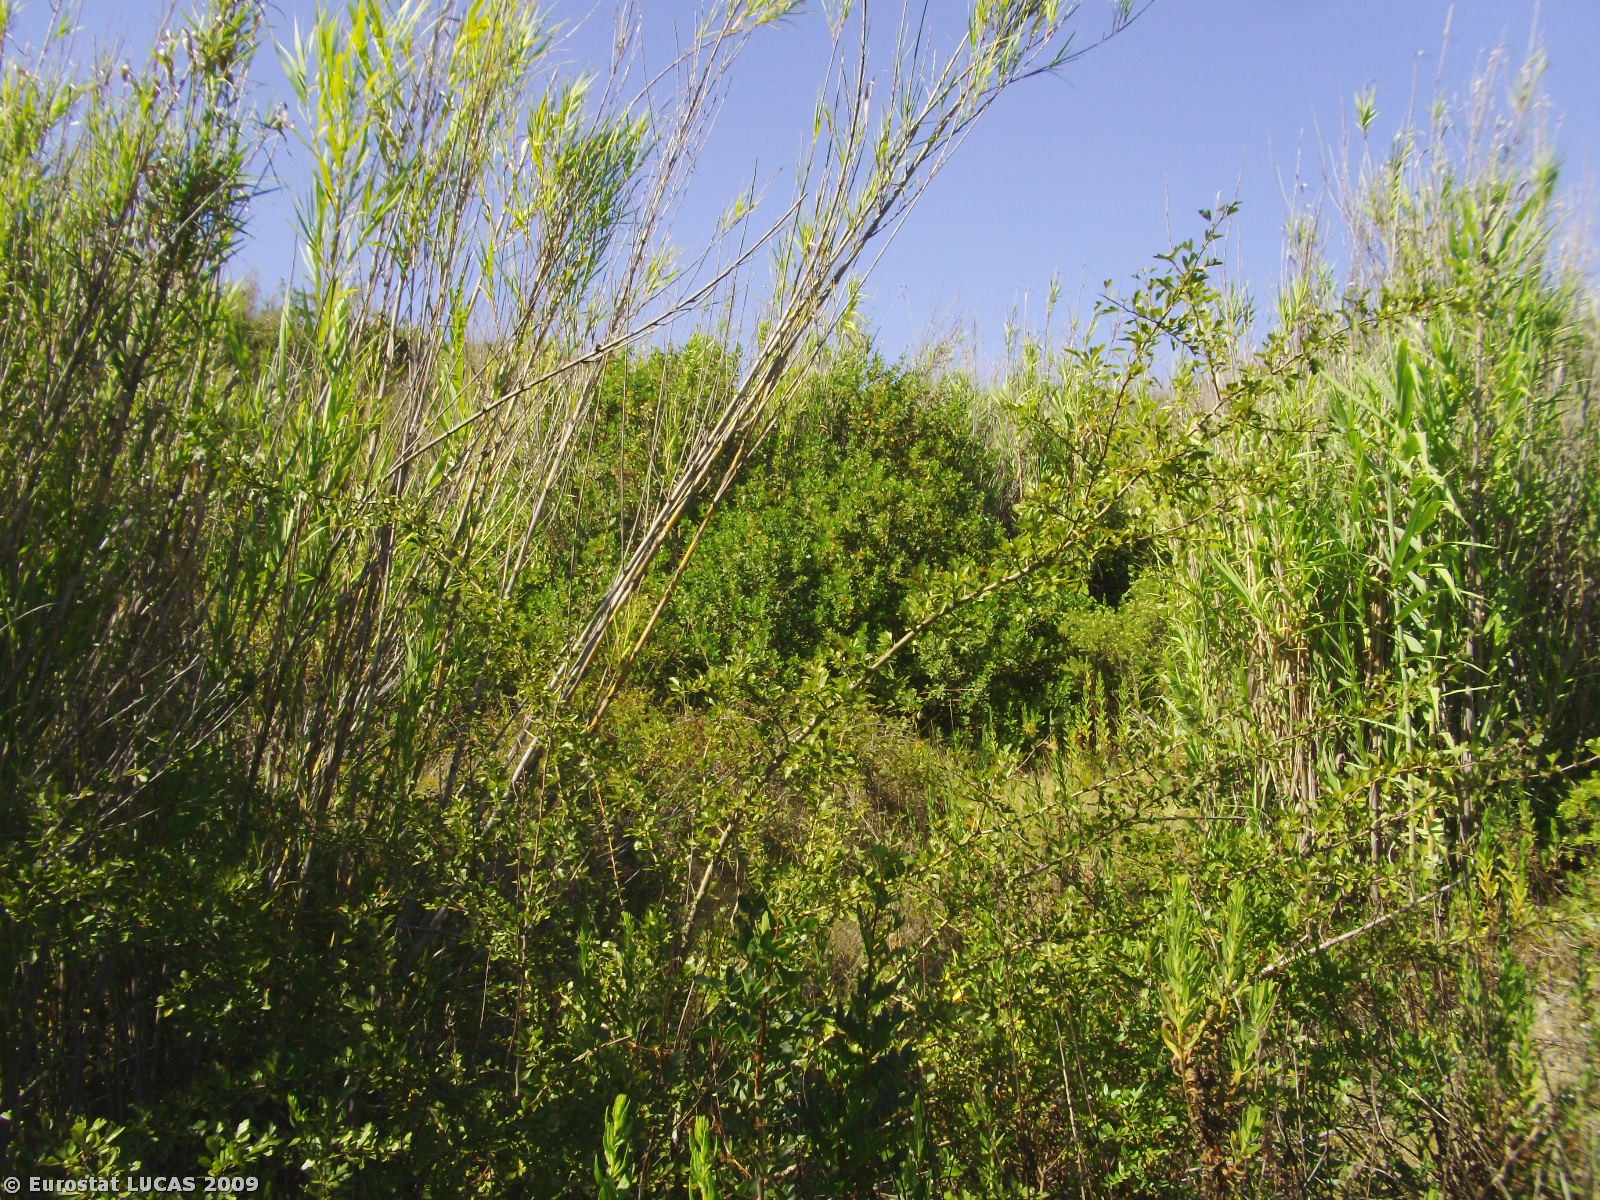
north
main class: Shrubland
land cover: Shrubland without tree cover
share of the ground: > 75 %
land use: Unused
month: July
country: PT
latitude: 39.1998
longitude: -8.8465
